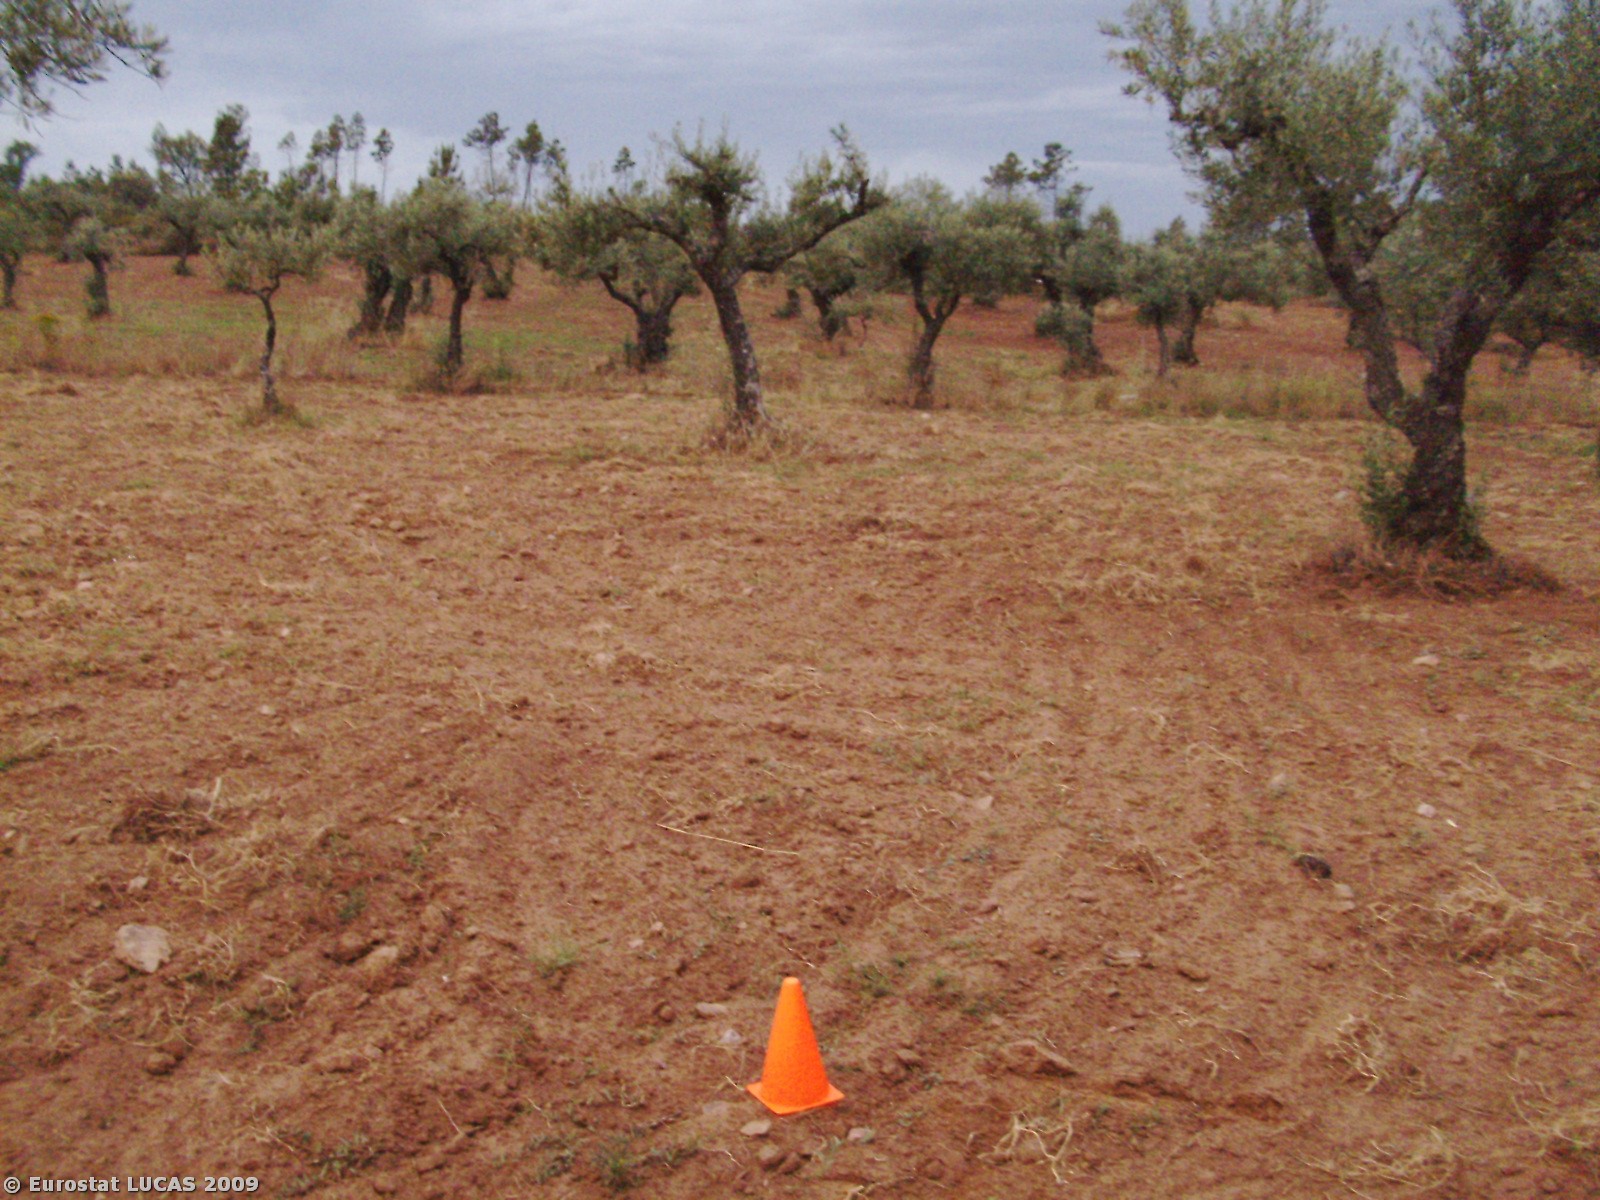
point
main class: Cropland
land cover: Olive groves
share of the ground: 50 - 75 %
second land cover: Bare land
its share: 25 - 50 %
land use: Agriculture (excluding fallow land and kitchen gardens)
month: June
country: PT
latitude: 39.9229
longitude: -7.5710
